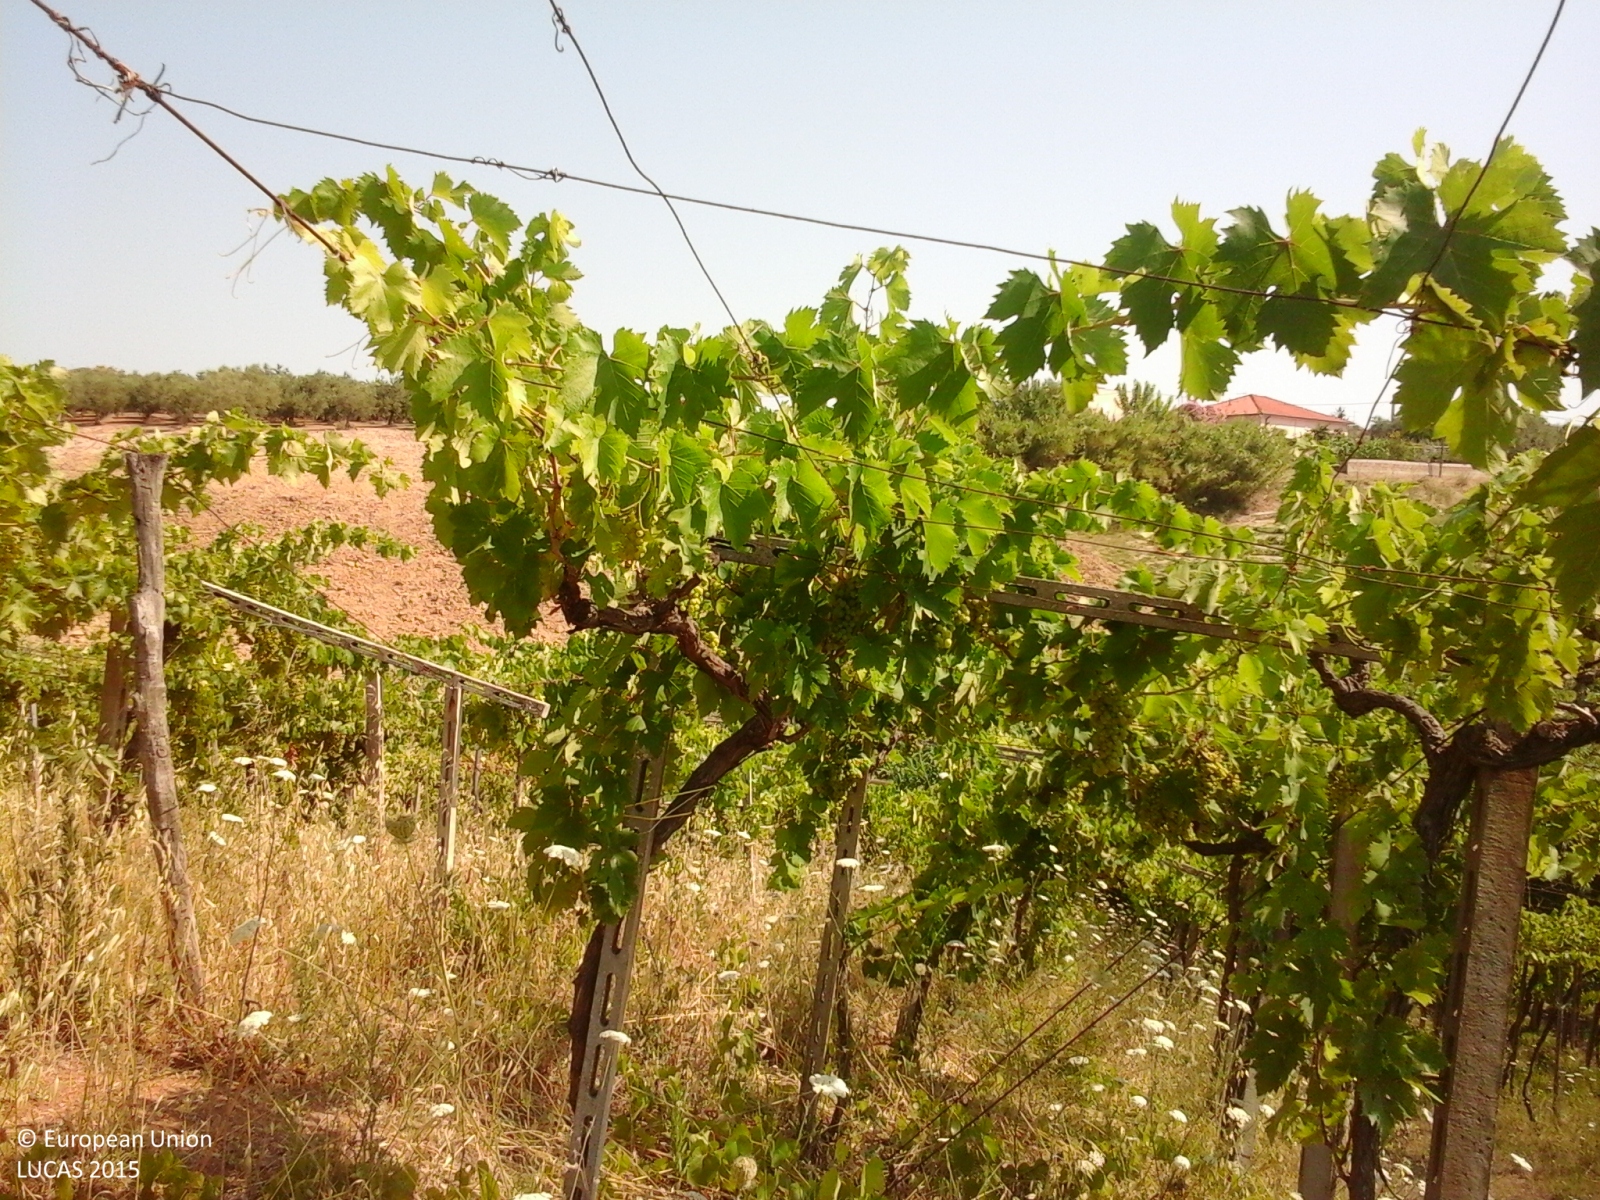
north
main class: Cropland
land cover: Vineyards
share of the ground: 50 - 75 %
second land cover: Spontaneously vegetated surfaces
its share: > 75 %
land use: Agriculture (excluding fallow land and kitchen gardens)
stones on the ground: 10 - 25 %
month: July
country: IT
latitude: 42.4200
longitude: 14.2531
